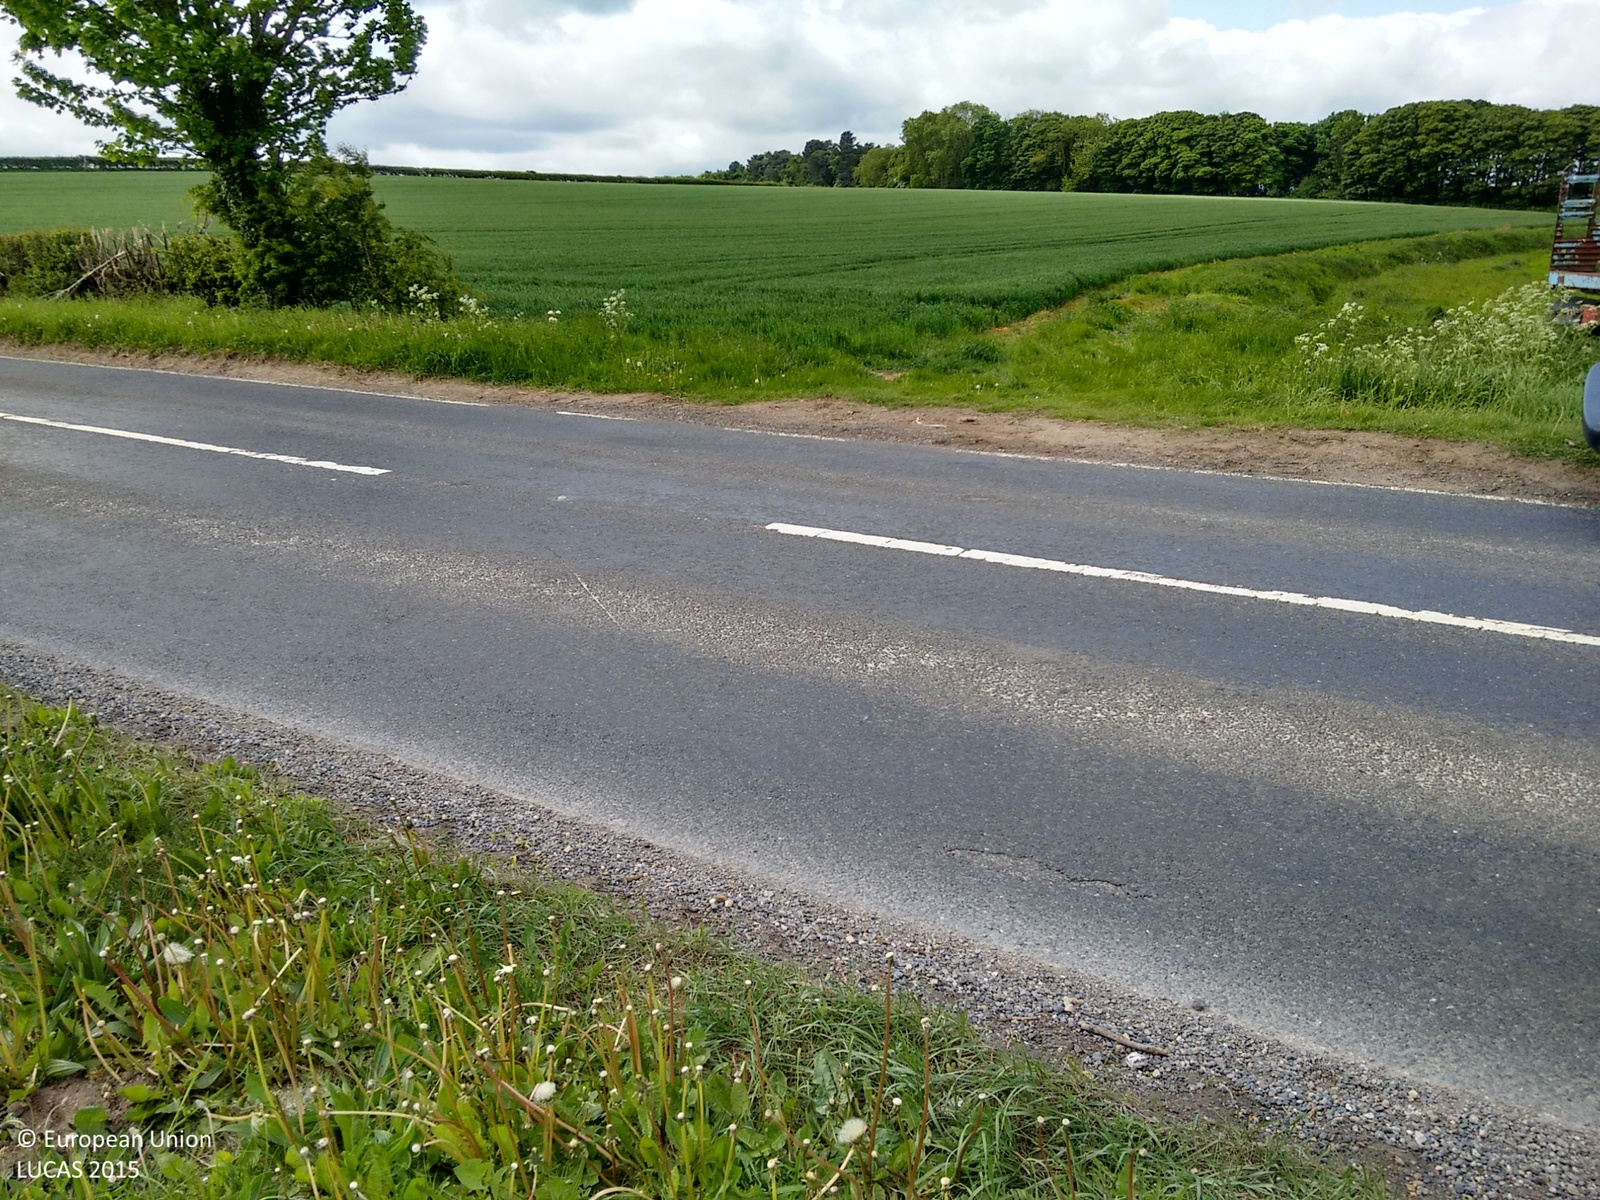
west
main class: Cropland
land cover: Potatoes
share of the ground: > 75 %
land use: Agriculture (excluding fallow land and kitchen gardens)
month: May
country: GB
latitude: 54.0485
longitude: -1.3340
